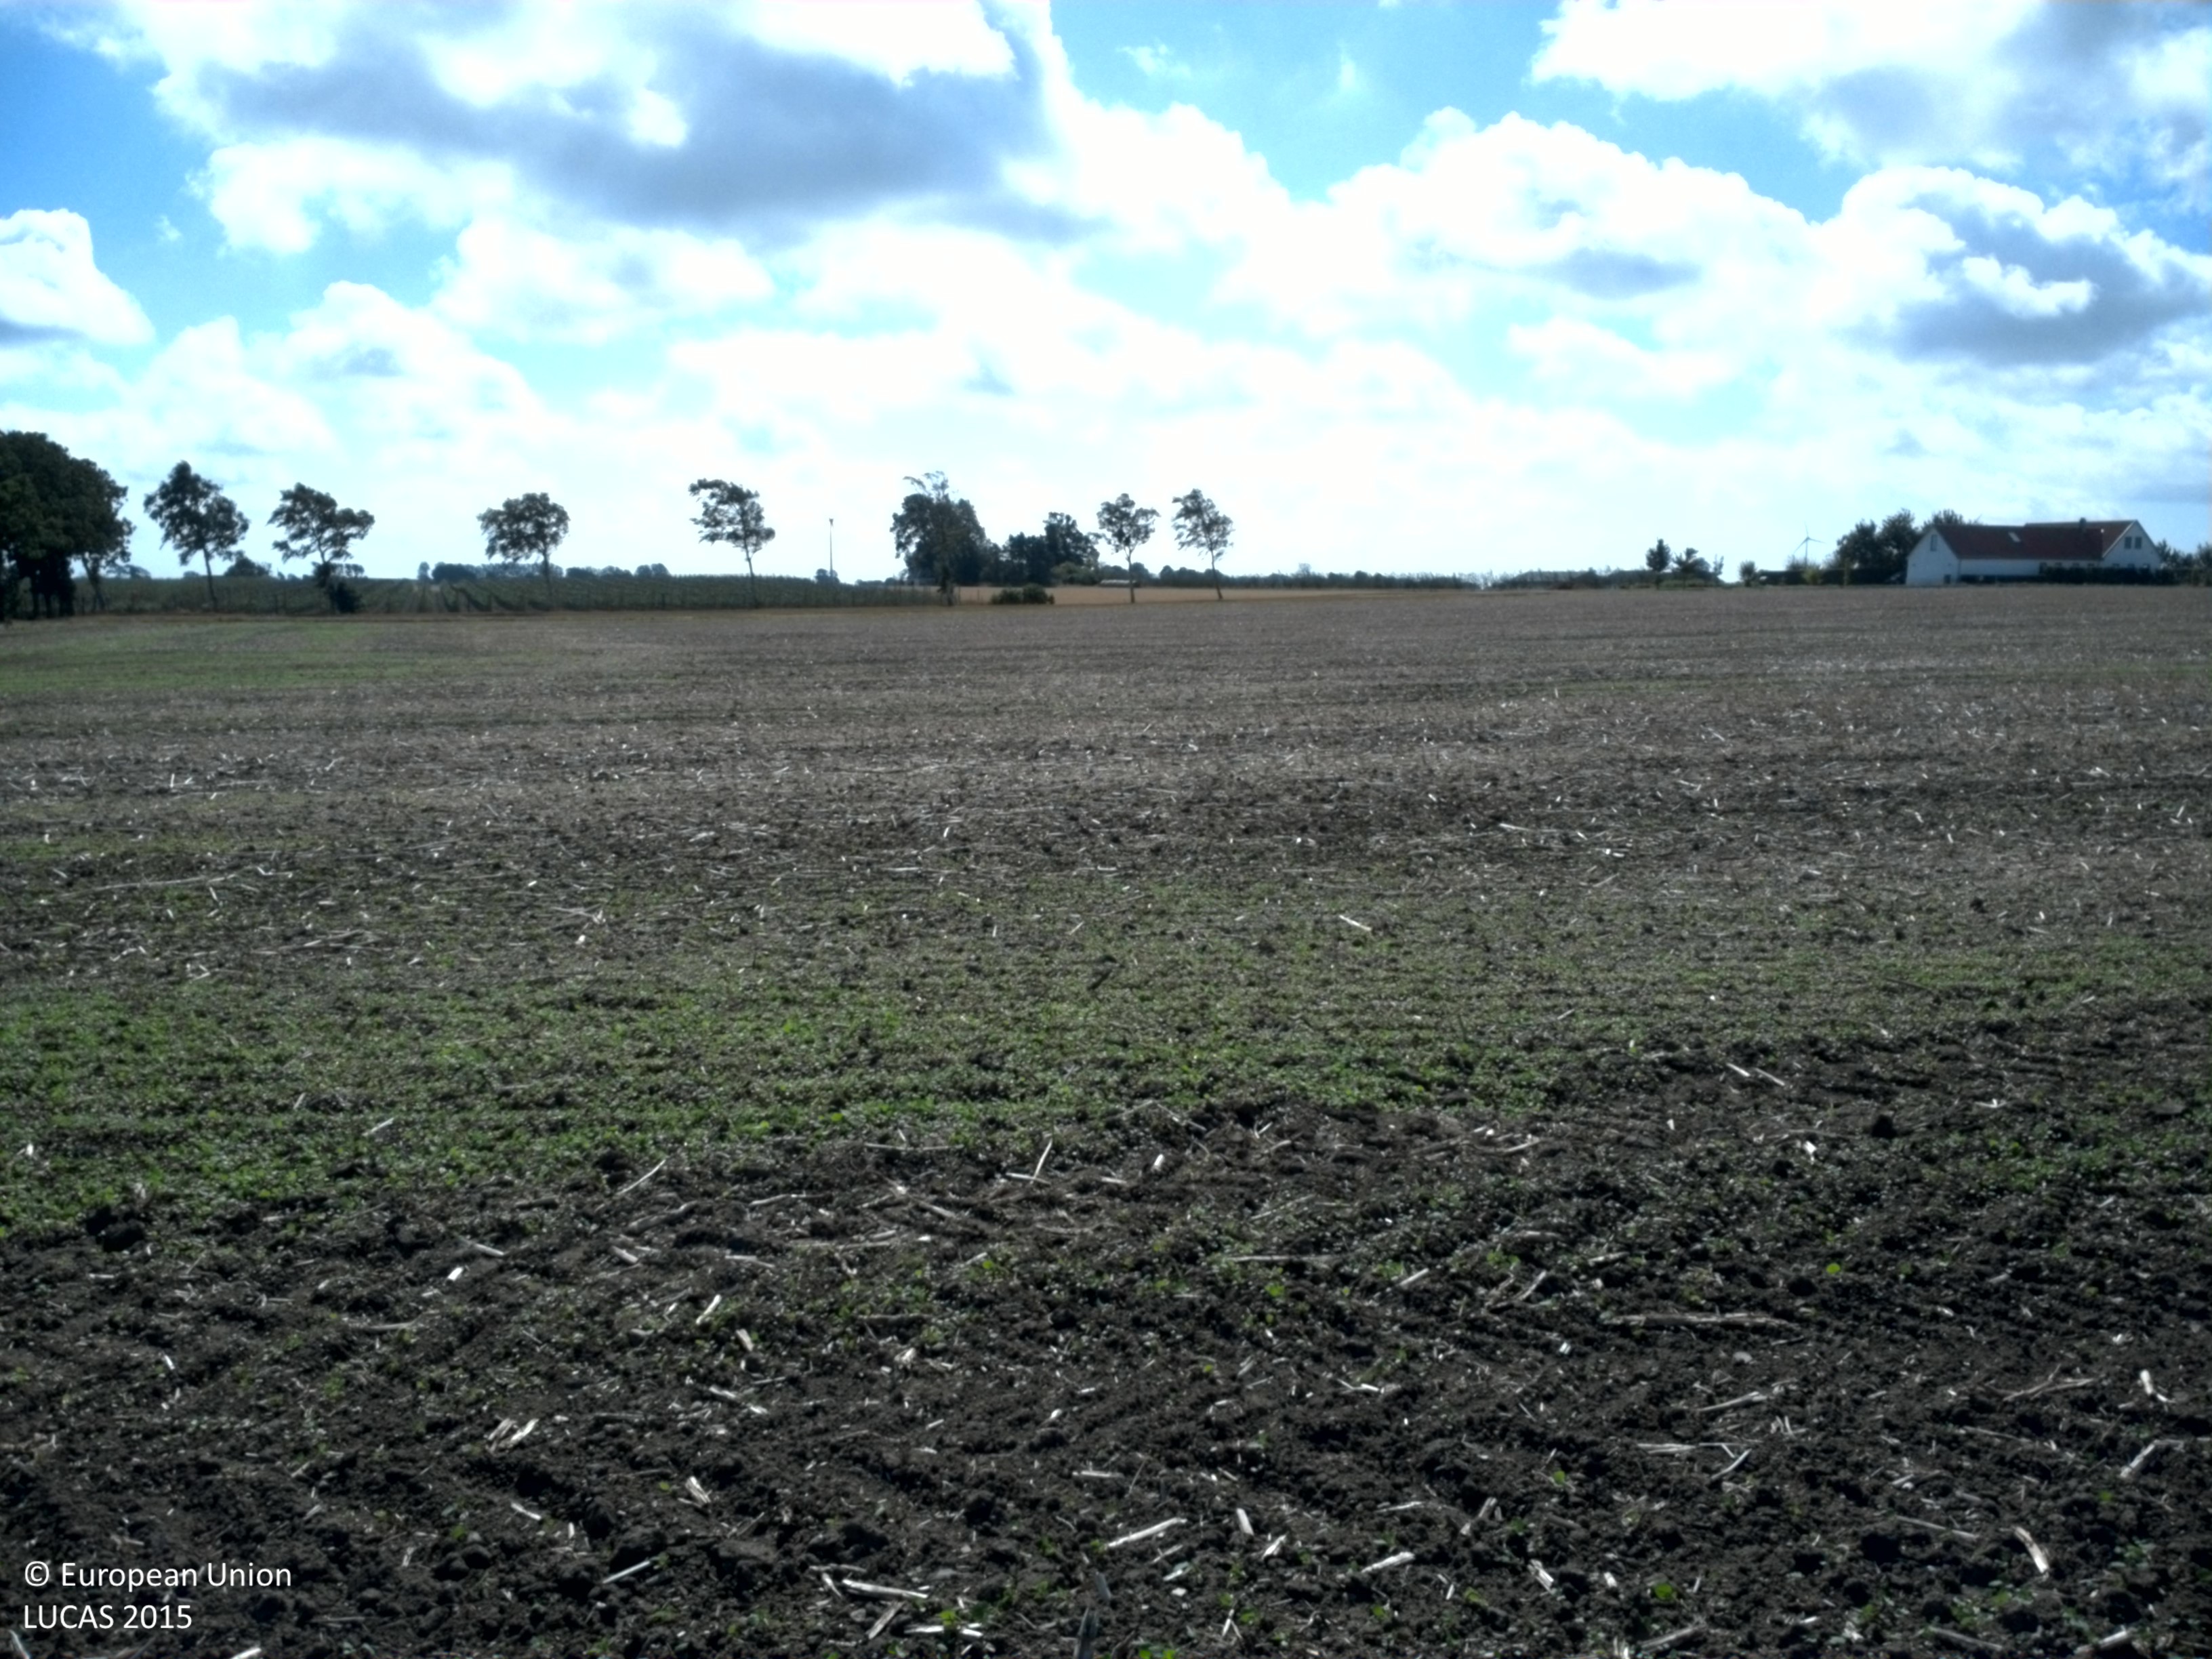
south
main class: Cropland
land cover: Rape and turnip rape
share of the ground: < 10 %
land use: Agriculture (excluding fallow land and kitchen gardens)
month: September
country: SE
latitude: 55.4893
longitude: 14.1927
